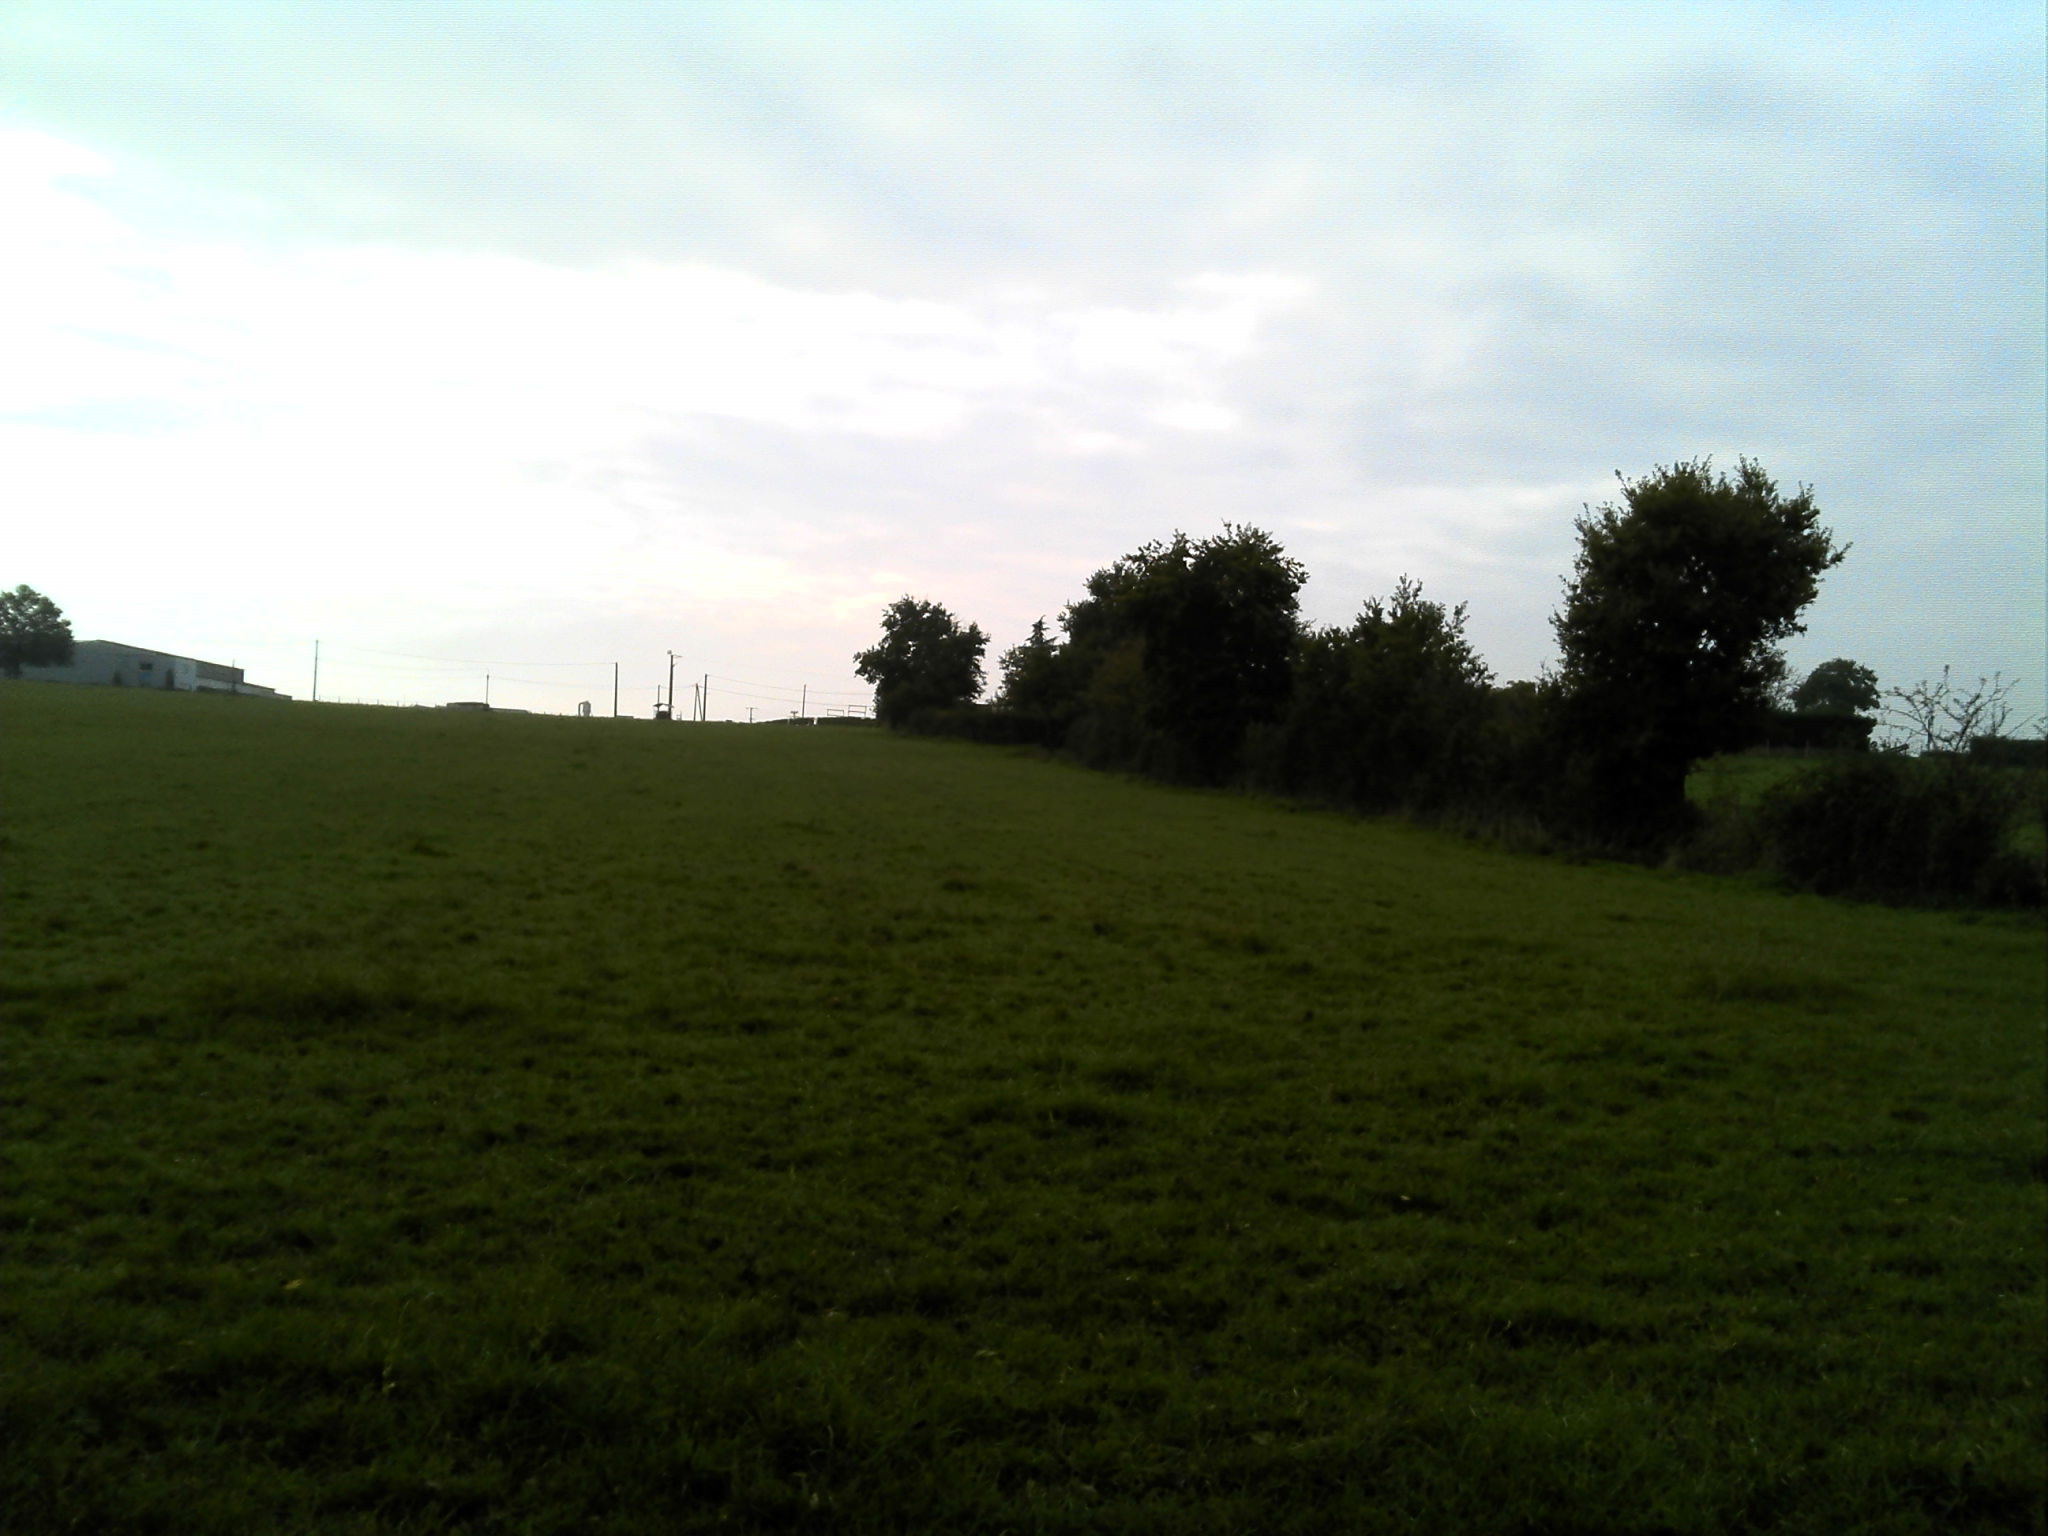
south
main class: Cropland
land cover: Temporary grasslands
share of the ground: > 75 %
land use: Agriculture (excluding fallow land and kitchen gardens)
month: October
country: FR
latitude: 47.2928
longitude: -0.9711
